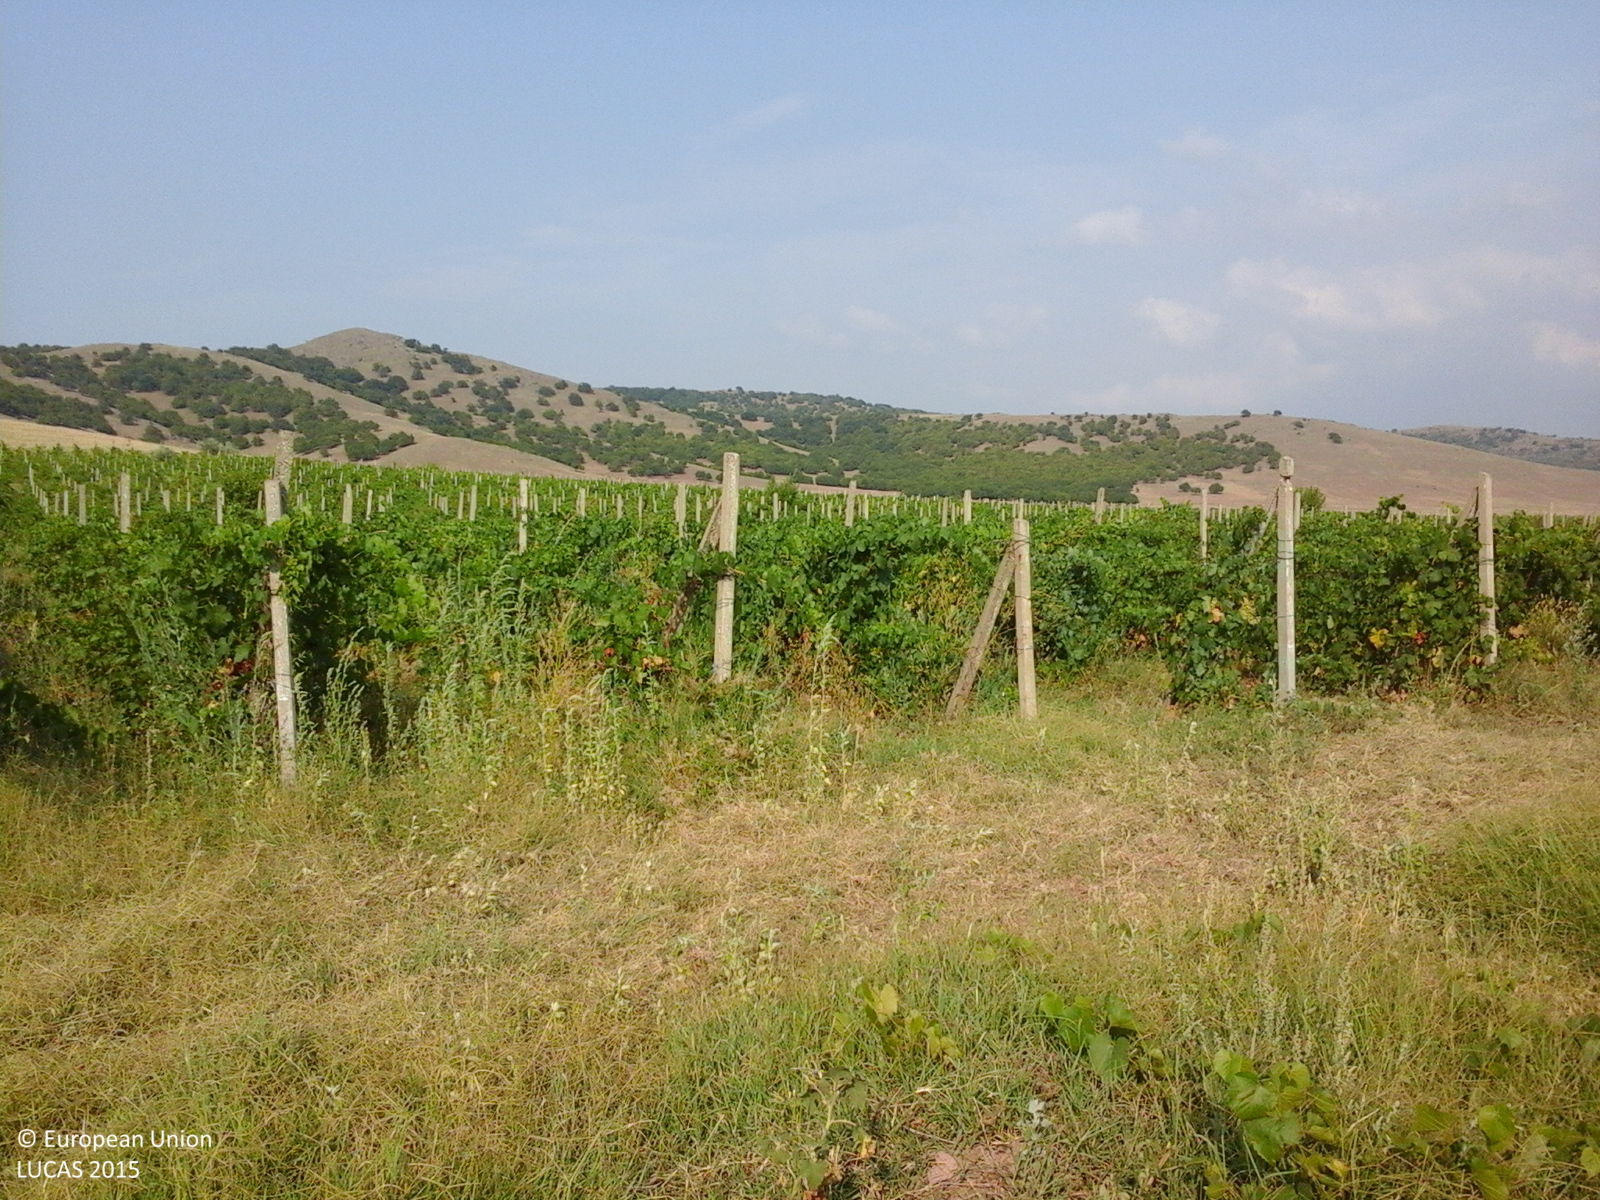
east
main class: Grassland
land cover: Grassland without tree/shrub cover
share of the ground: > 75 %
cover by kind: herbaceous plants 100 %
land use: Agriculture (excluding fallow land and kitchen gardens)
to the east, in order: Grassland without tree/shrub cover; Vineyards
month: July
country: RO
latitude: 45.1080
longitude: 28.2852
